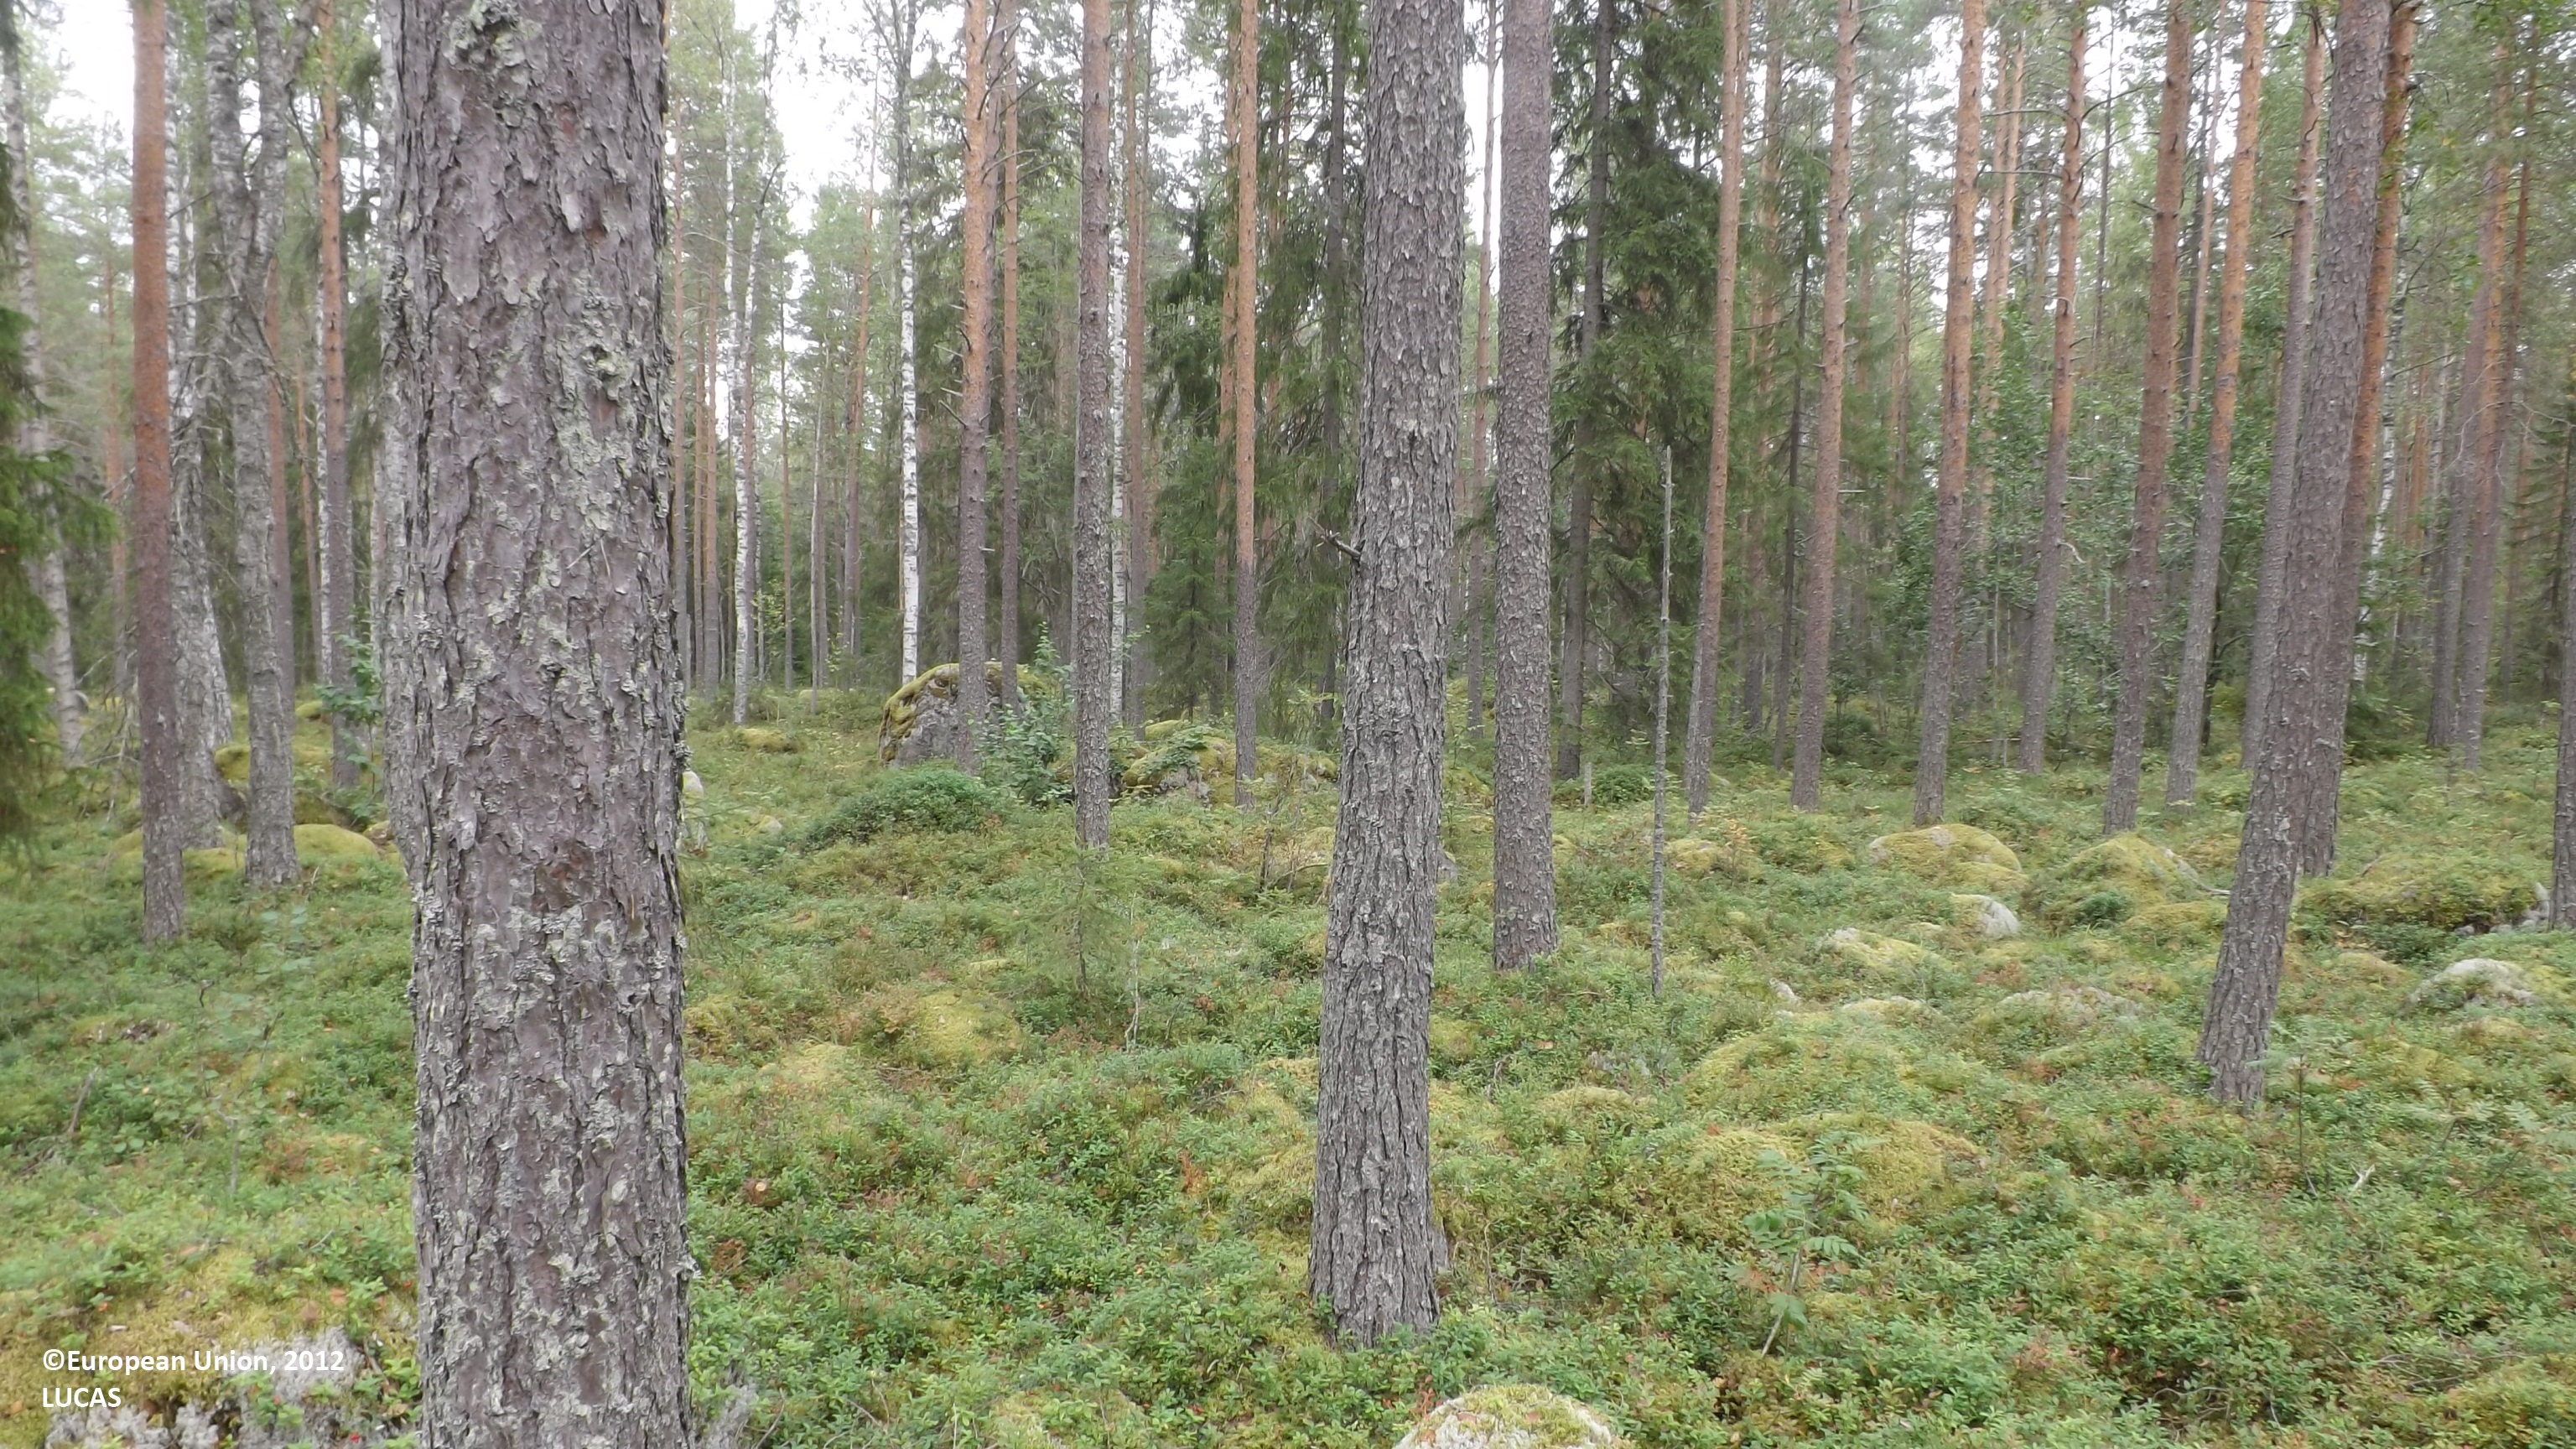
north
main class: Woodland
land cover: Pine dominated coniferous woodland
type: boreal forest
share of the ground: 50 - 75 %
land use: Forestry
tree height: > 5 m
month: August
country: FI
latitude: 63.9672
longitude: 24.0973
